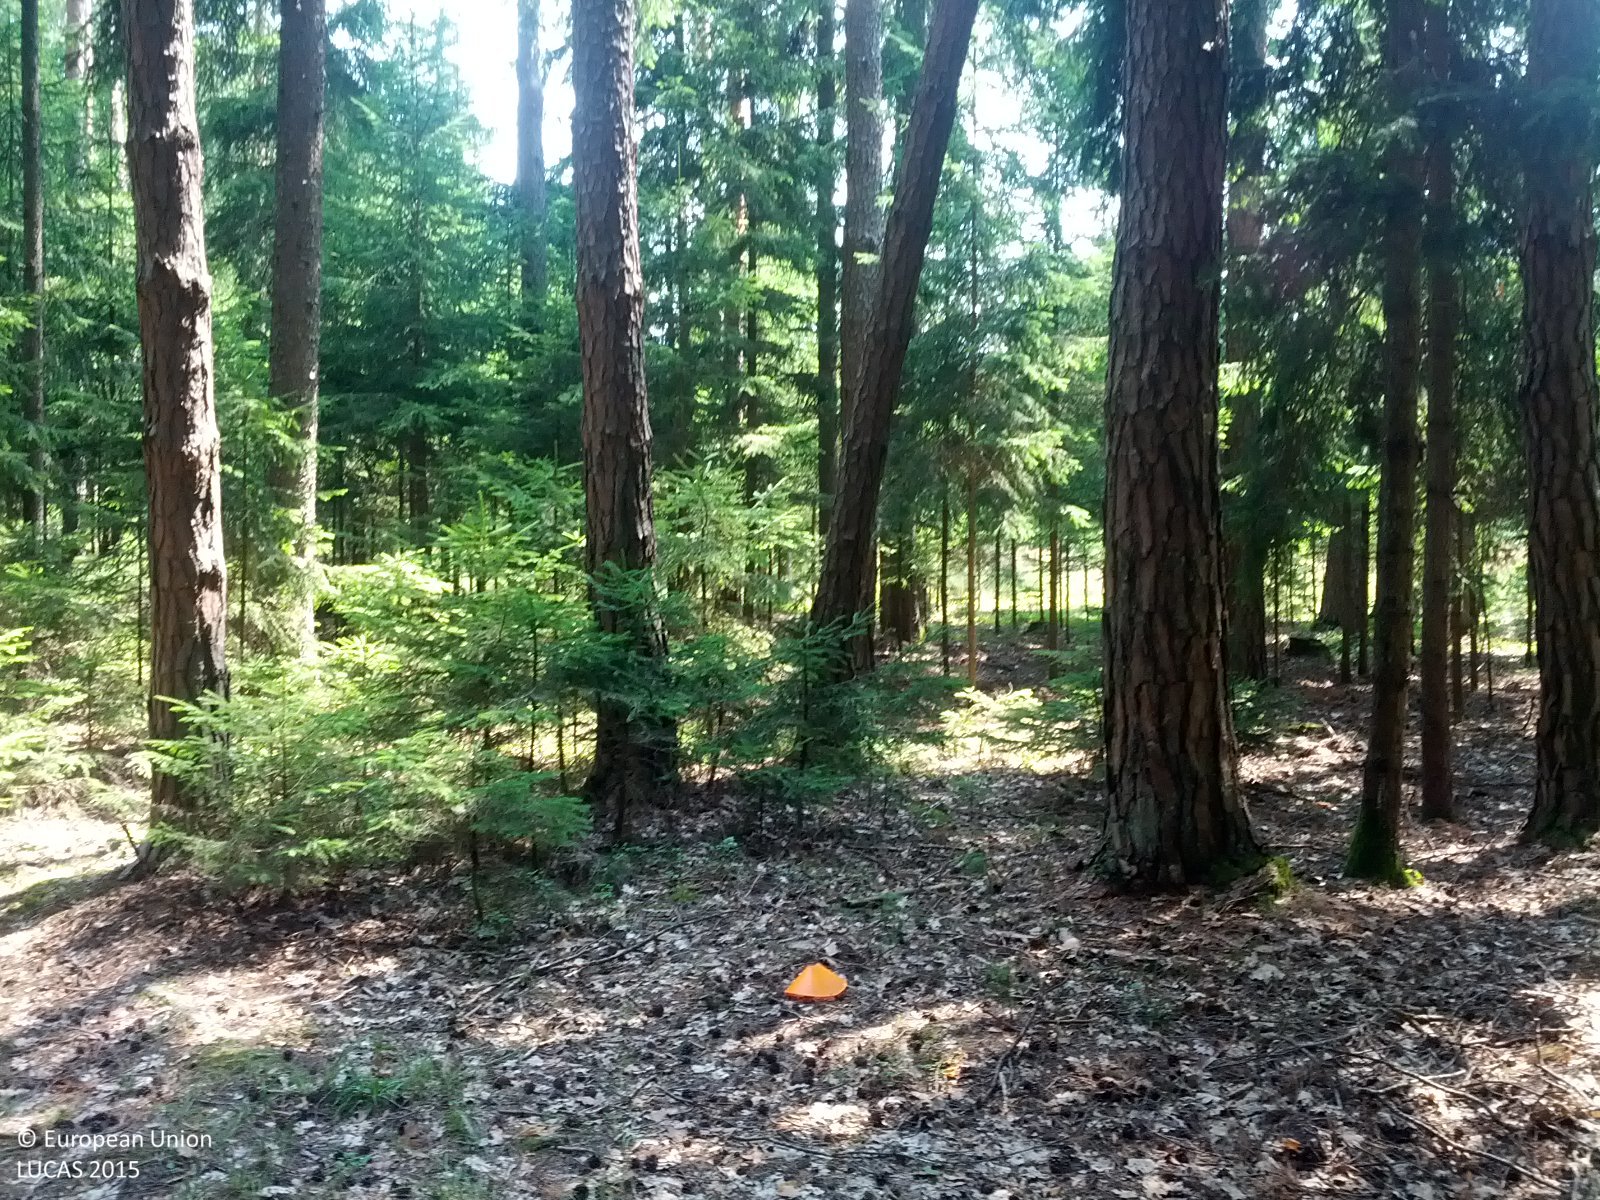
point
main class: Woodland
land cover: Pine dominated coniferous woodland
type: hemiboreal forest and nemoral coniferous forest and mixed broadleaved-coniferous forest
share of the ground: > 75 %
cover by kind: coniferous forest trees 90 %, broadleaved forest trees 5 %, herbaceous plants 5 %
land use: Forestry
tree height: > 5 m
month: July
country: AT
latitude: 47.2235
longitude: 16.1164
